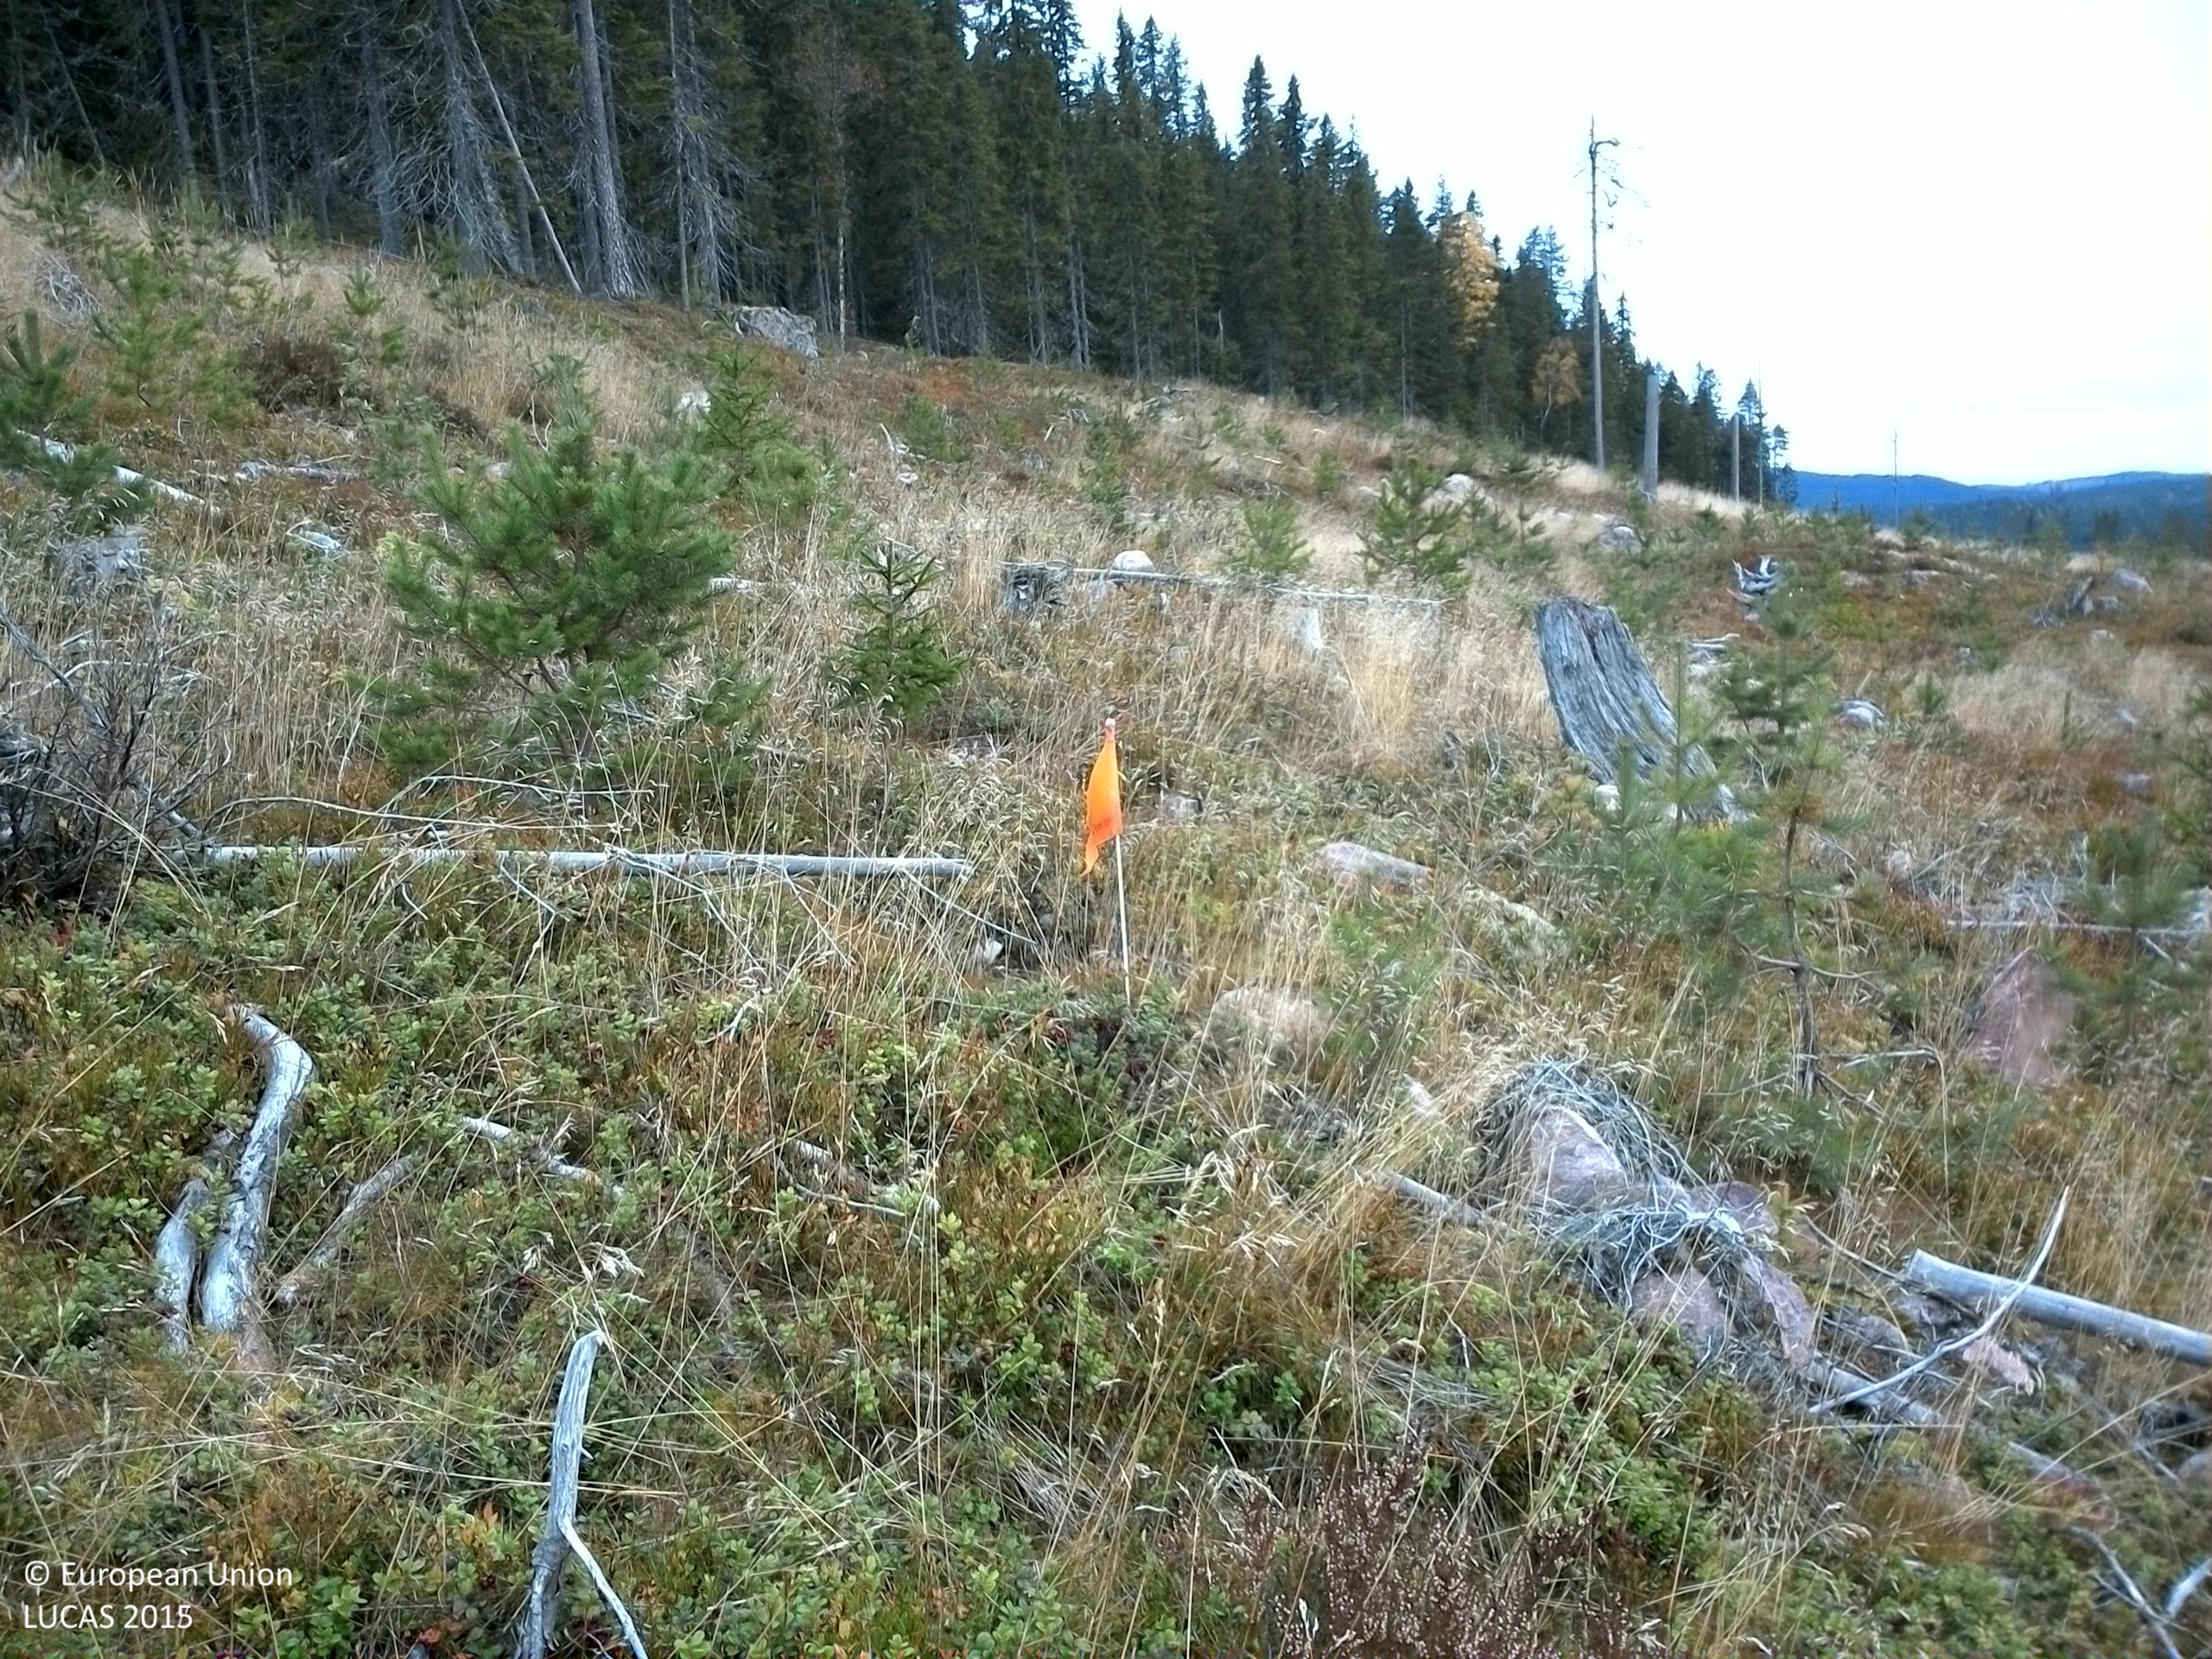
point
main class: Woodland
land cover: Pine dominated coniferous woodland
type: boreal forest
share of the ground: 25 - 50 %
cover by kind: shrubs 55 %, coniferous forest trees 25 %, herbaceous plants 10 %, lichens and mosses 10 %
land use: Forestry
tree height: < 5 m
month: October
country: SE
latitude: 61.2674
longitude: 14.3683
